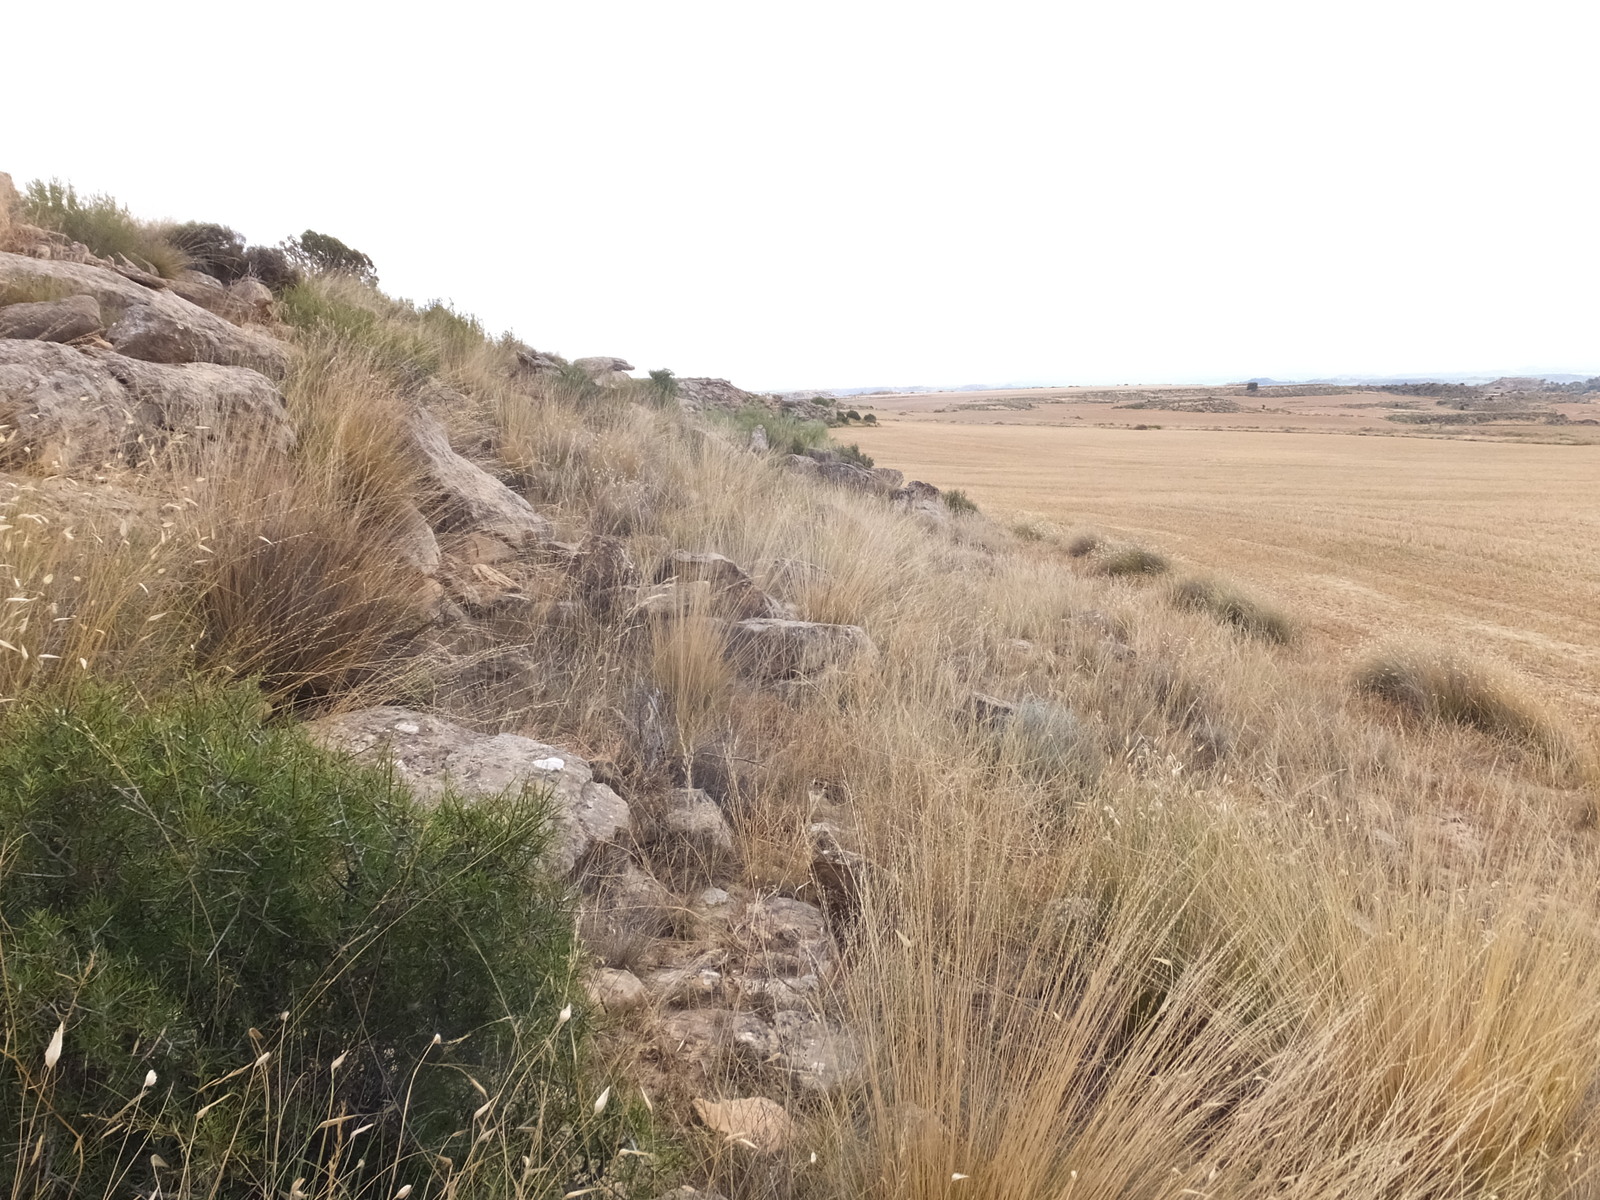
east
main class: Shrubland
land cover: Shrubland without tree cover
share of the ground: 50 - 75 %
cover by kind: herbaceous plants 50 %, shrubs 25 %, lichens and mosses 25 %
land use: Semi-natural and natural areas not in use
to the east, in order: Shrubland without tree cover; Durum wheat; Shrubland without tree cover; Durum wheat
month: June
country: ES
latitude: 41.3151
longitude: -0.0595
